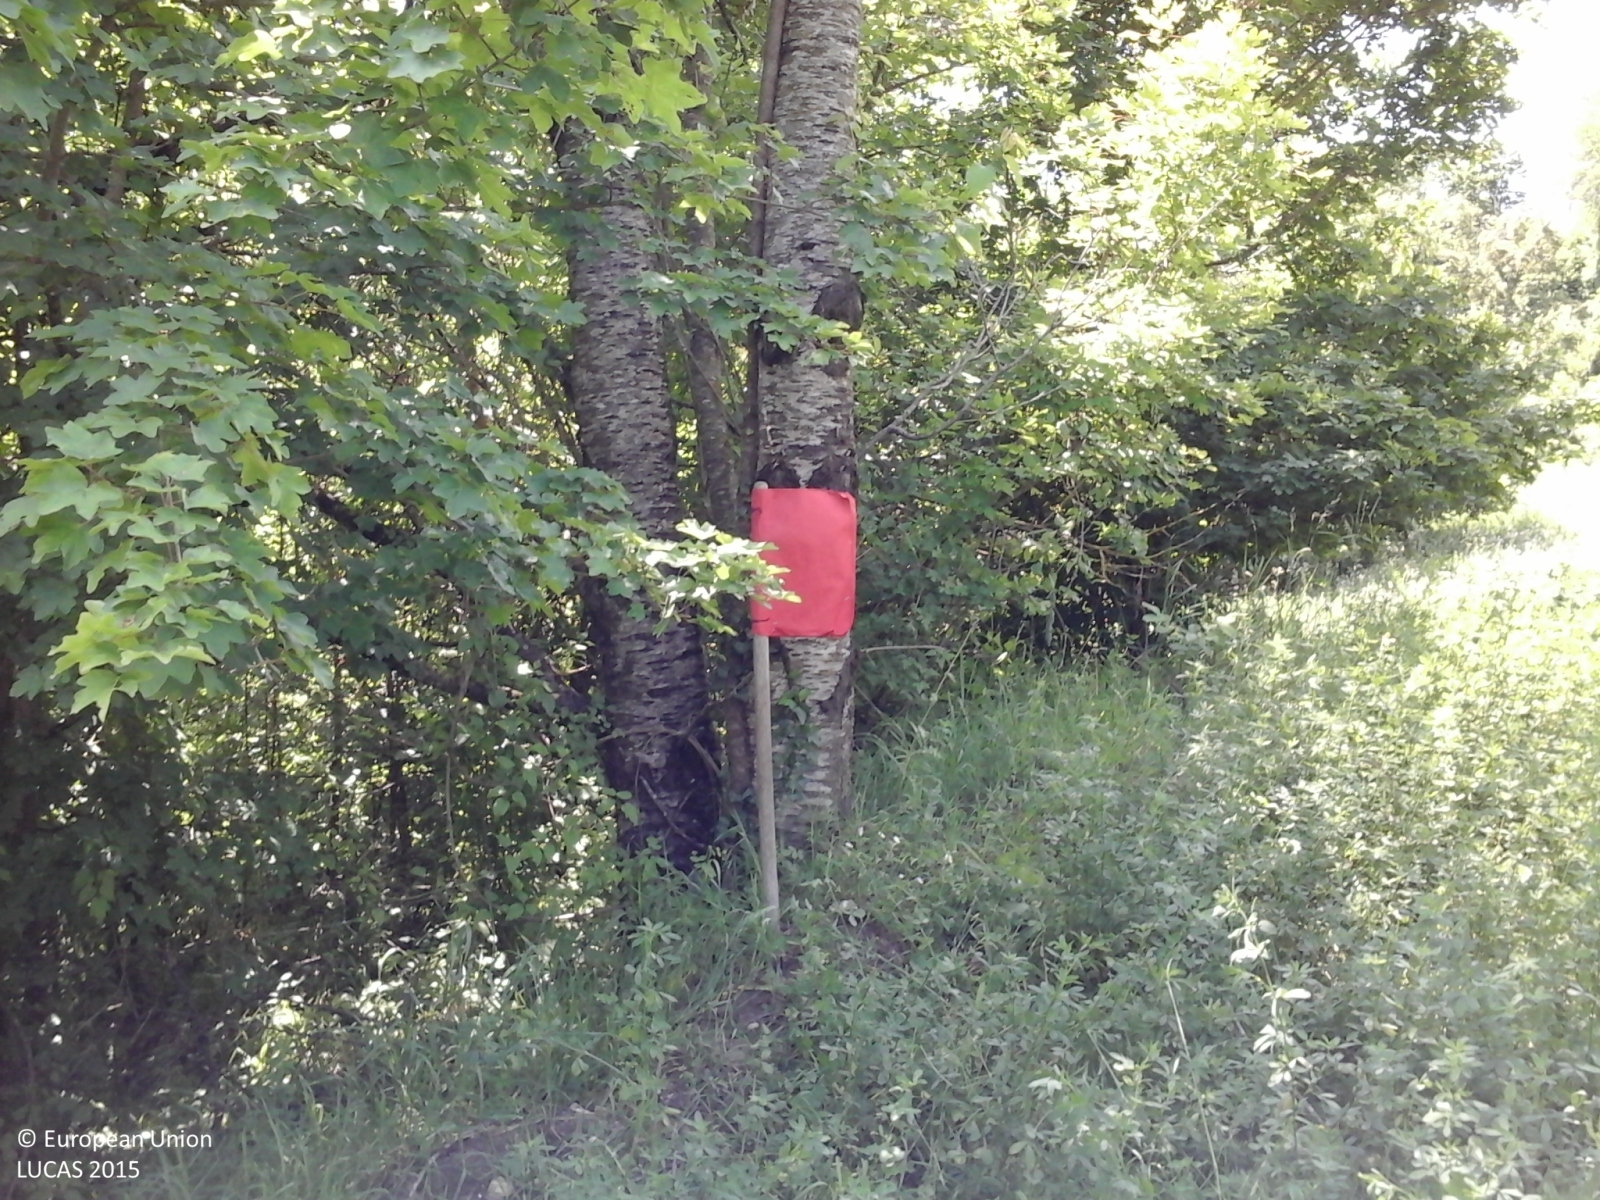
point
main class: Woodland
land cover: Broadleaved woodland
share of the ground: > 75 %
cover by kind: broadleaved forest trees 90 %, shrubs 10 %
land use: Forestry
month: May
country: IT
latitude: 44.5488
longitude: 10.1633
